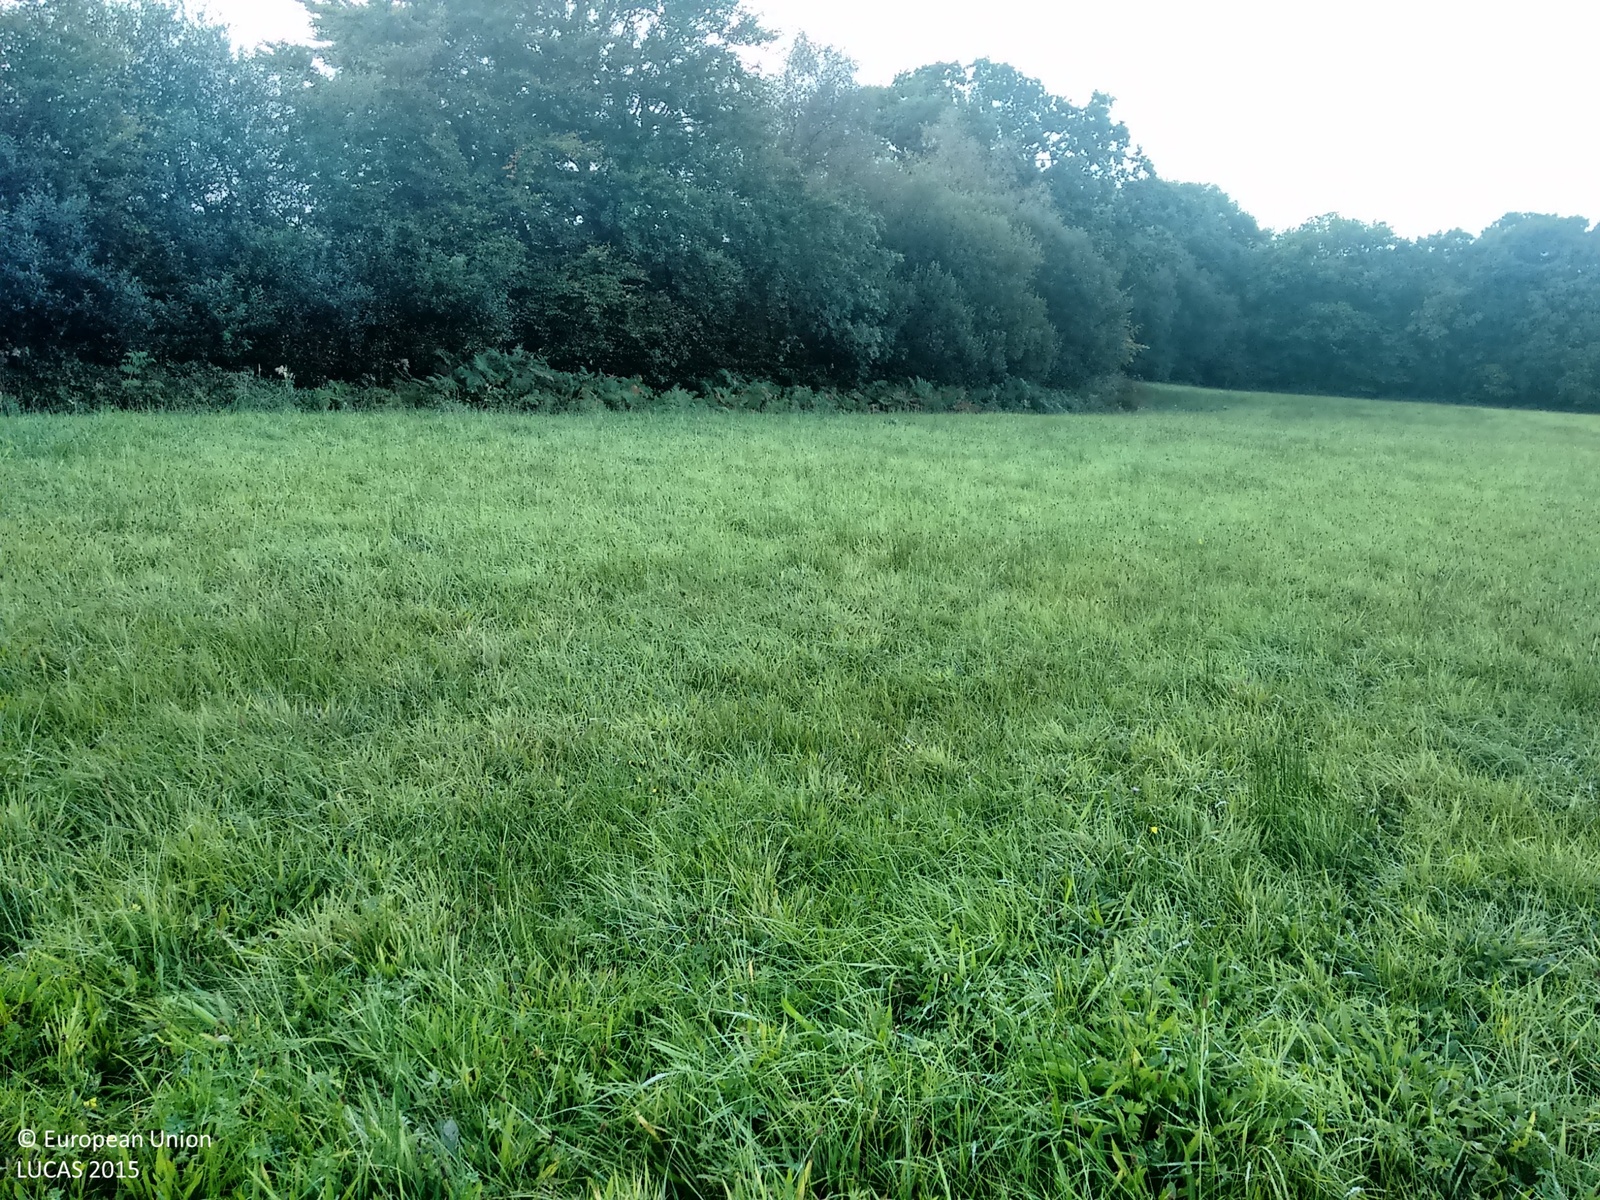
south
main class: Grassland
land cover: Grassland without tree/shrub cover
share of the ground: > 75 %
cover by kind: herbaceous plants 100 %
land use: Agriculture (excluding fallow land and kitchen gardens)
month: September
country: GB
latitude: 50.7082
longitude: -4.1011
